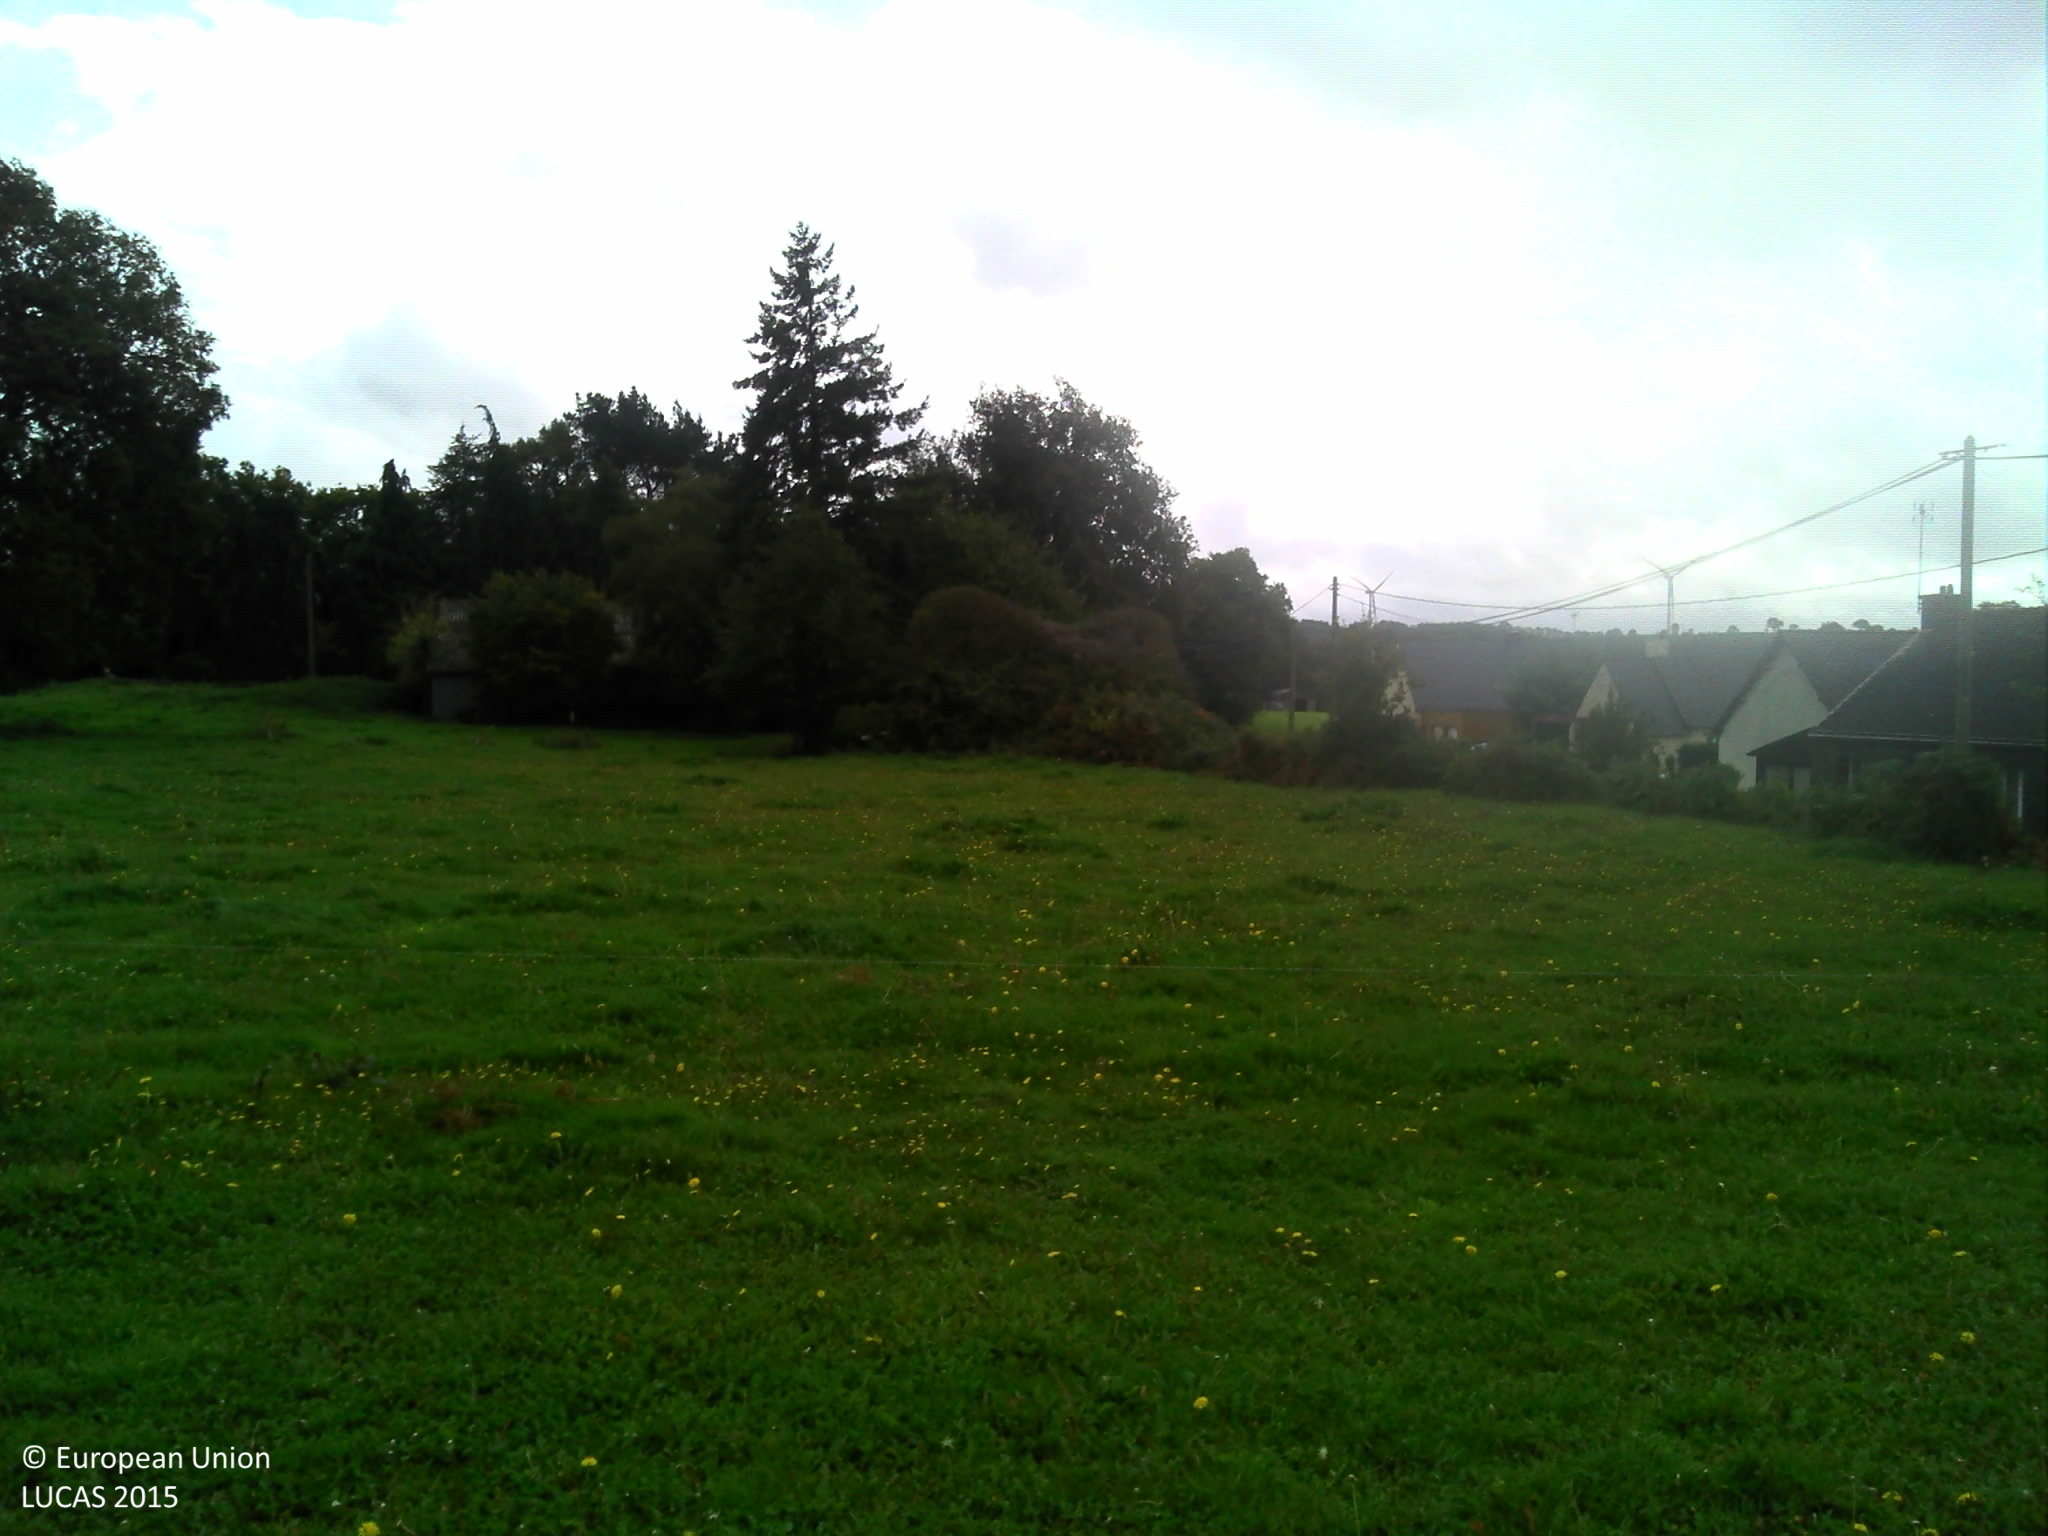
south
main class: Grassland
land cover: Grassland without tree/shrub cover
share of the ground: > 75 %
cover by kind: herbaceous plants 100 %
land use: Agriculture (excluding fallow land and kitchen gardens)
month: October
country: FR
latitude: 47.7959
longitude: -2.2162
